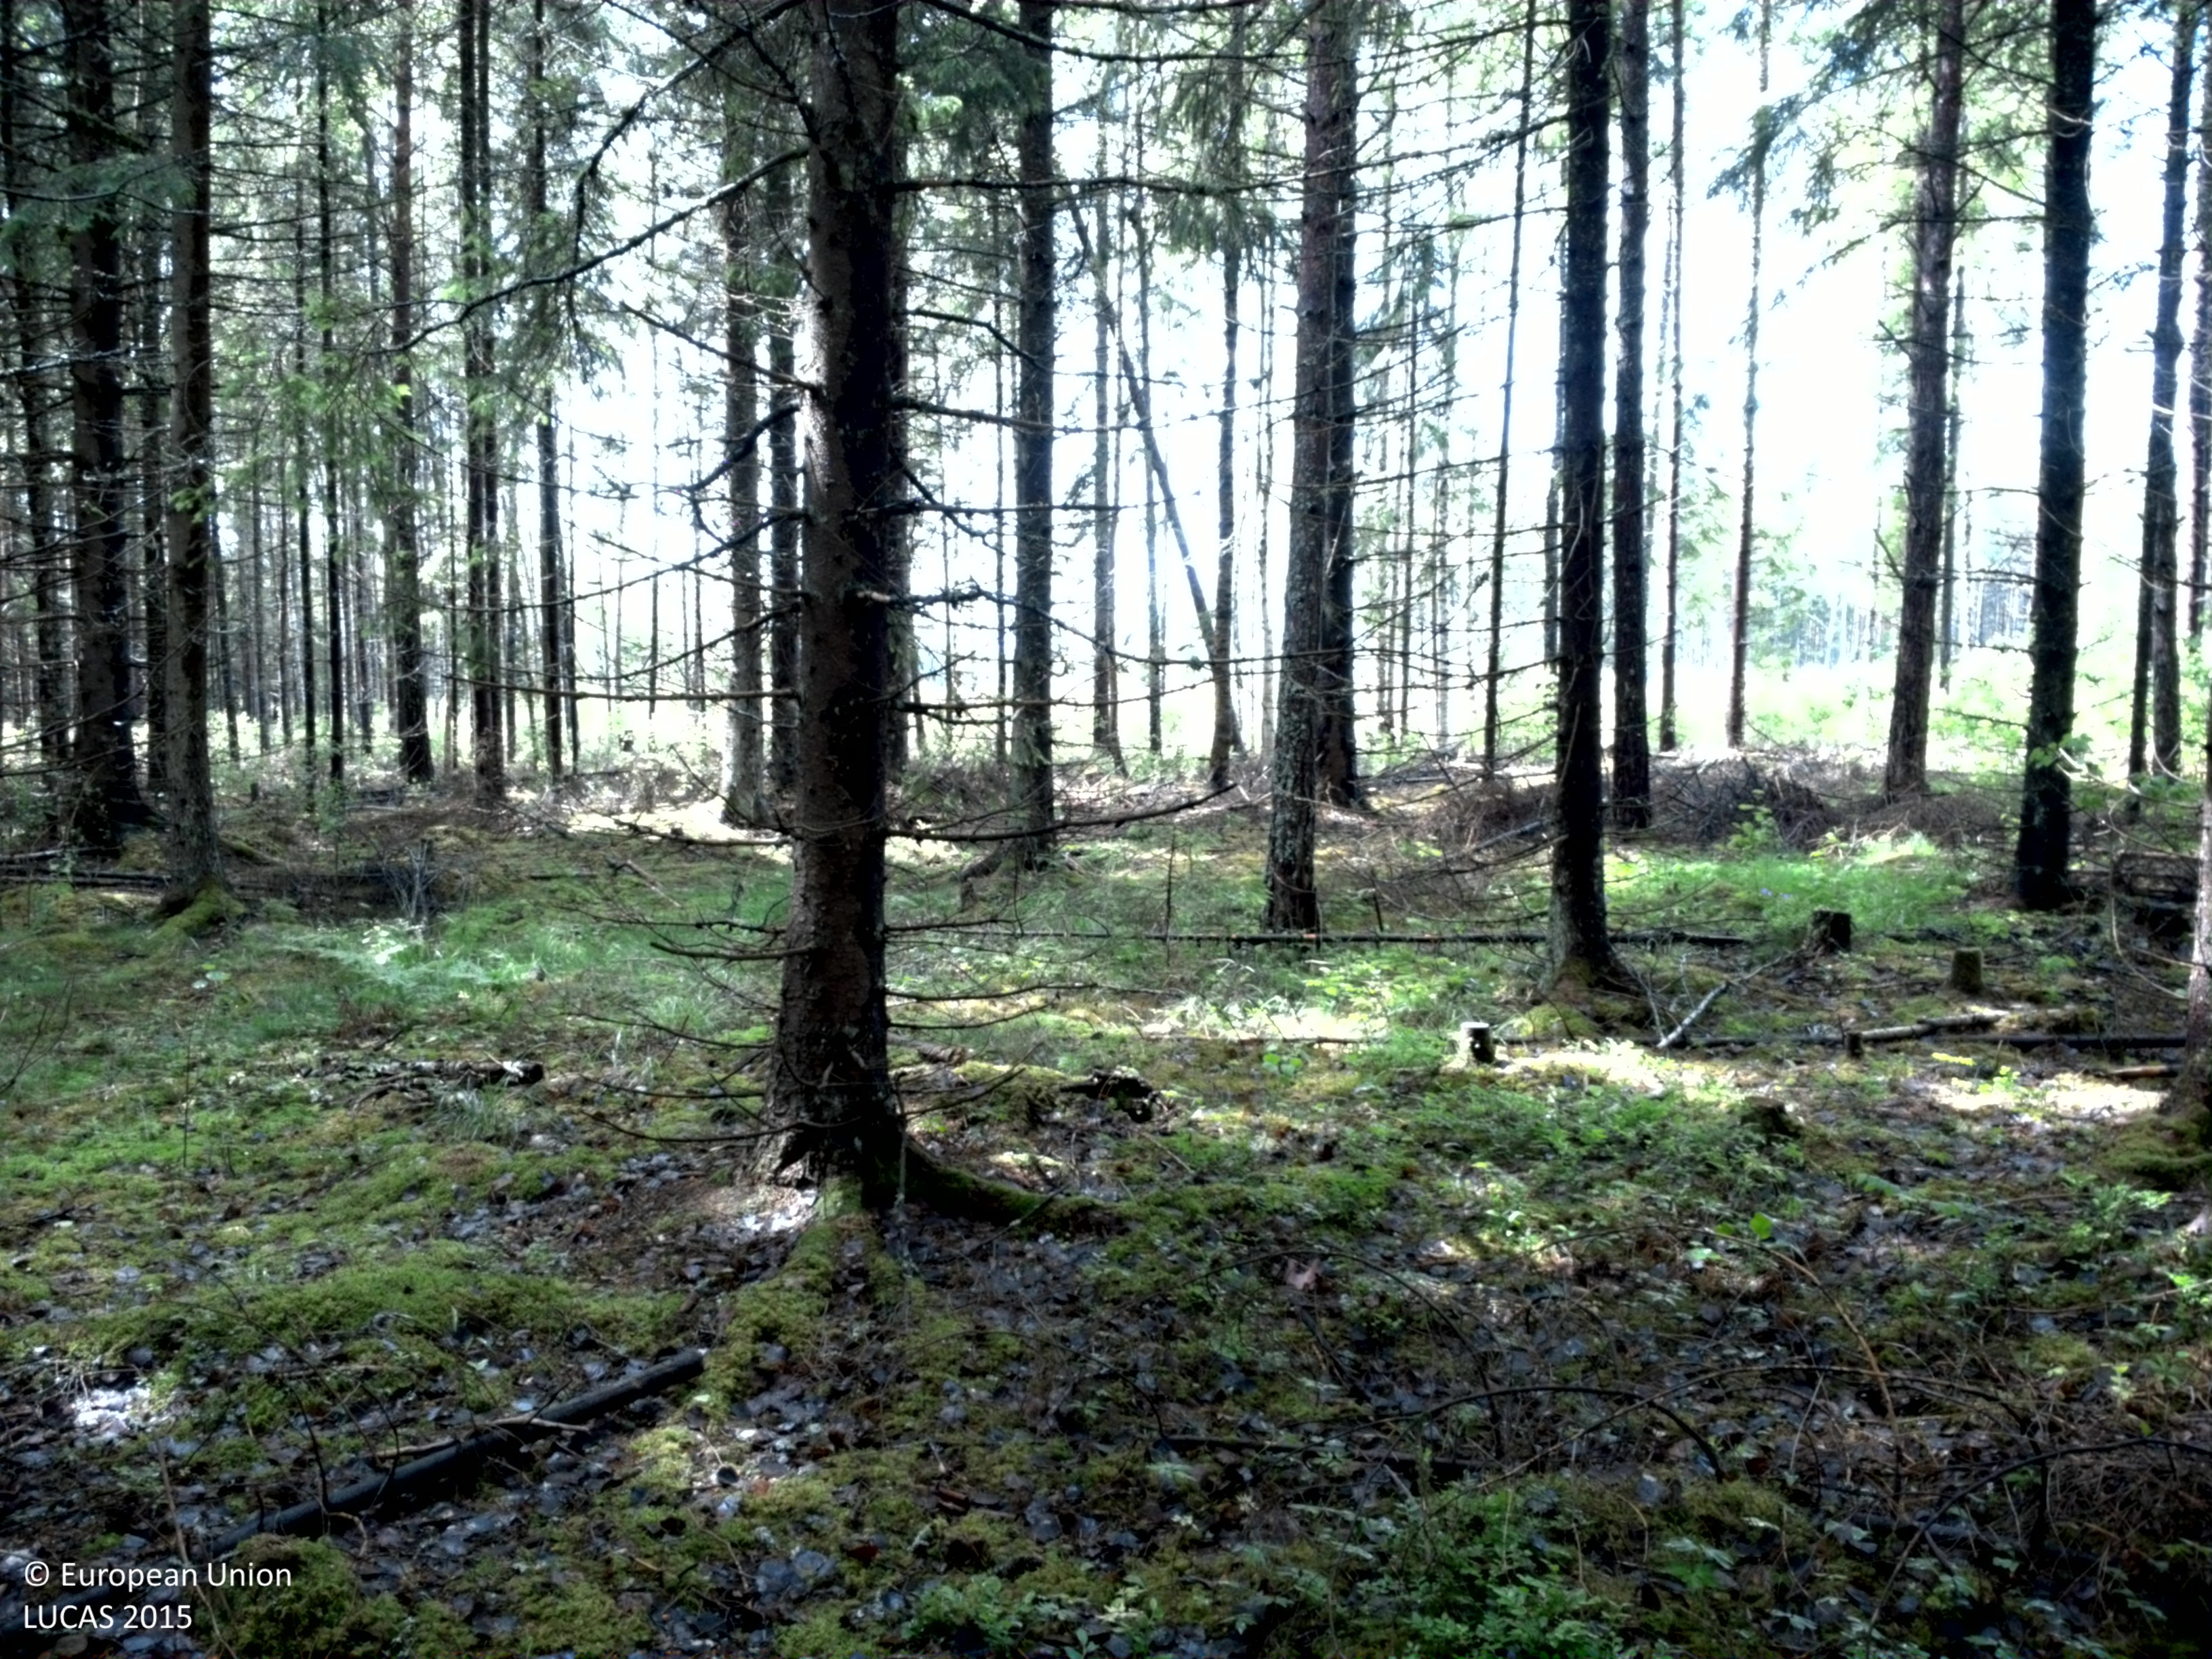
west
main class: Woodland
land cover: Spruce dominated coniferous woodland
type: boreal forest
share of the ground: > 75 %
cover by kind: coniferous forest trees 85 %, broadleaved forest trees 5 %, herbaceous plants 5 %, lichens and mosses 5 %
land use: Forestry
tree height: > 5 m
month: June
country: SE
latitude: 59.8581
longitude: 17.0805
